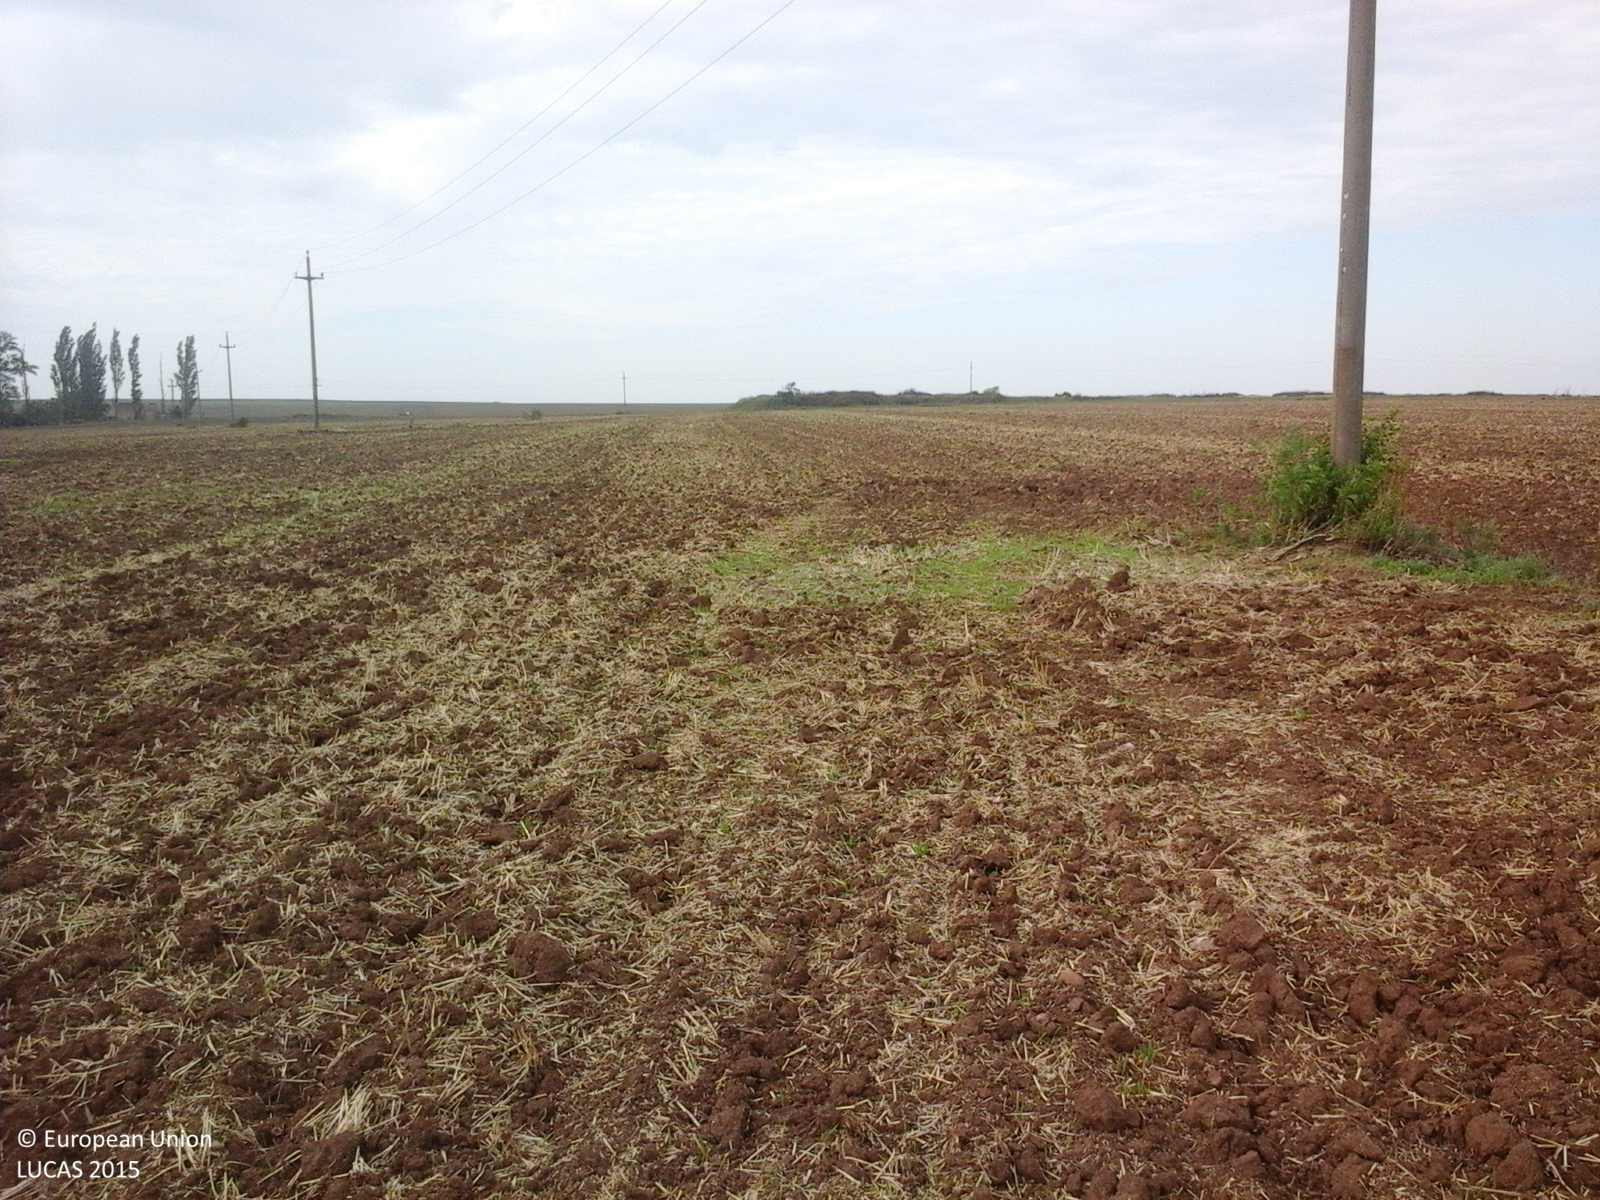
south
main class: Cropland
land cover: Common wheat
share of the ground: 10 - 25 %
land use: Agriculture (excluding fallow land and kitchen gardens)
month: August
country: RO
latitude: 46.1026
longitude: 21.4056
